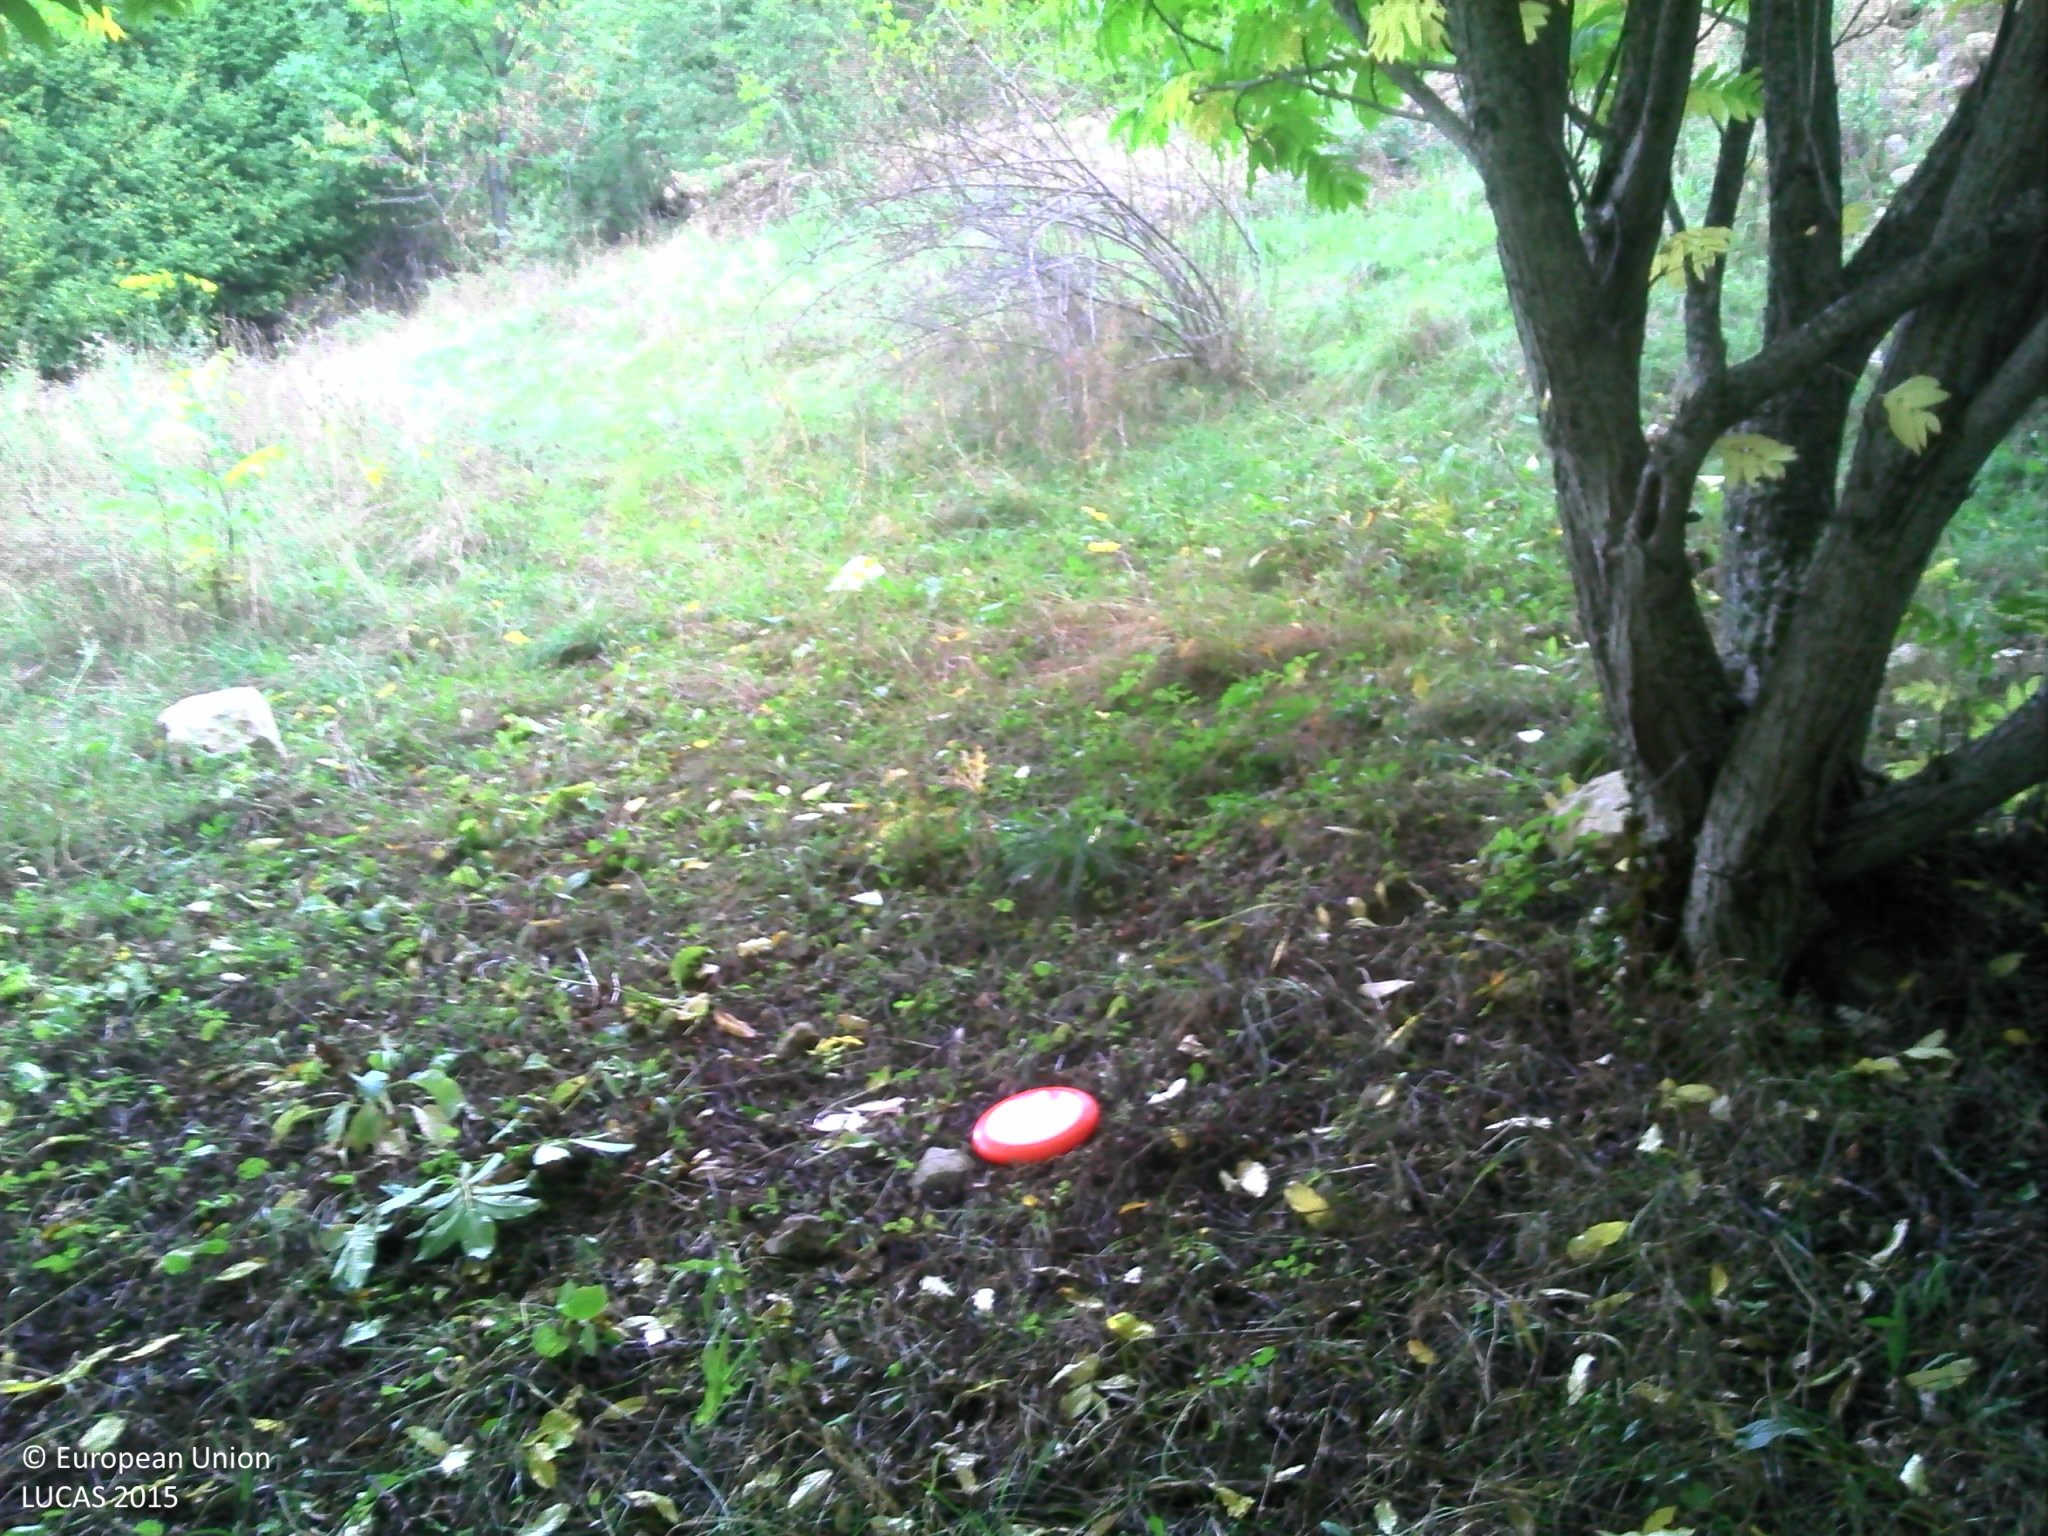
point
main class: Cropland
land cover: Nuts trees
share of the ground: 50 - 75 %
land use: Agriculture (excluding fallow land and kitchen gardens)
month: September
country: FR
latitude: 44.4346
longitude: 5.5222
